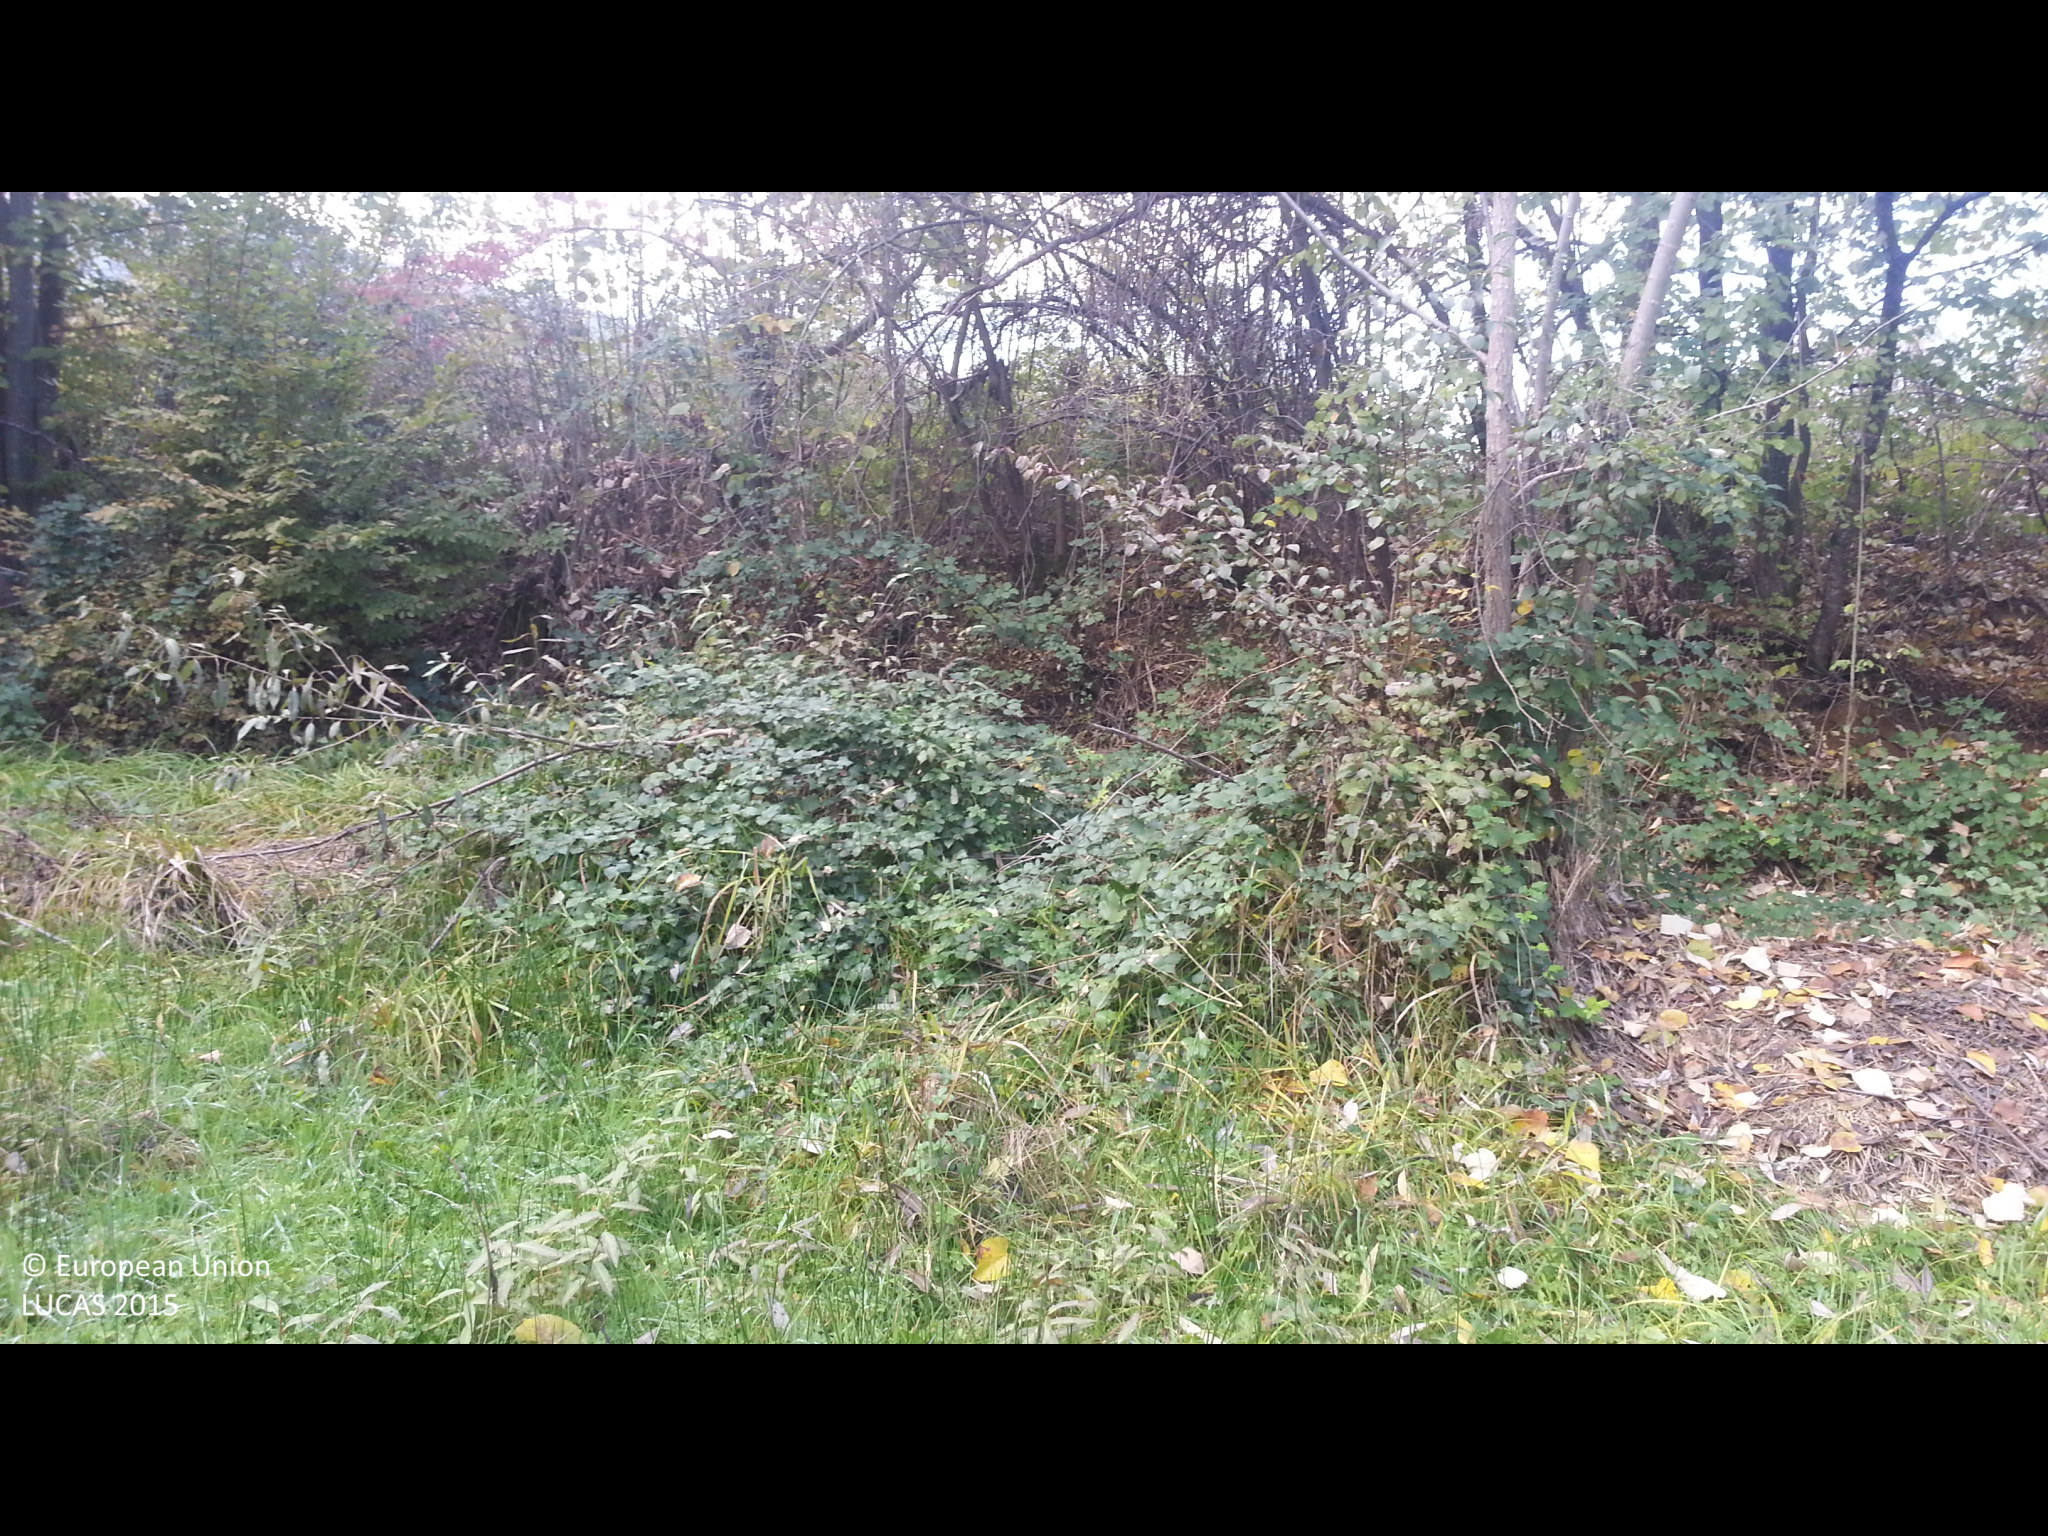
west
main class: Grassland
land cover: Grassland without tree/shrub cover
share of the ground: > 75 %
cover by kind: herbaceous plants 100 %
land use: Agriculture (excluding fallow land and kitchen gardens)
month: November
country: BG
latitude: 42.8983
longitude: 23.8959
